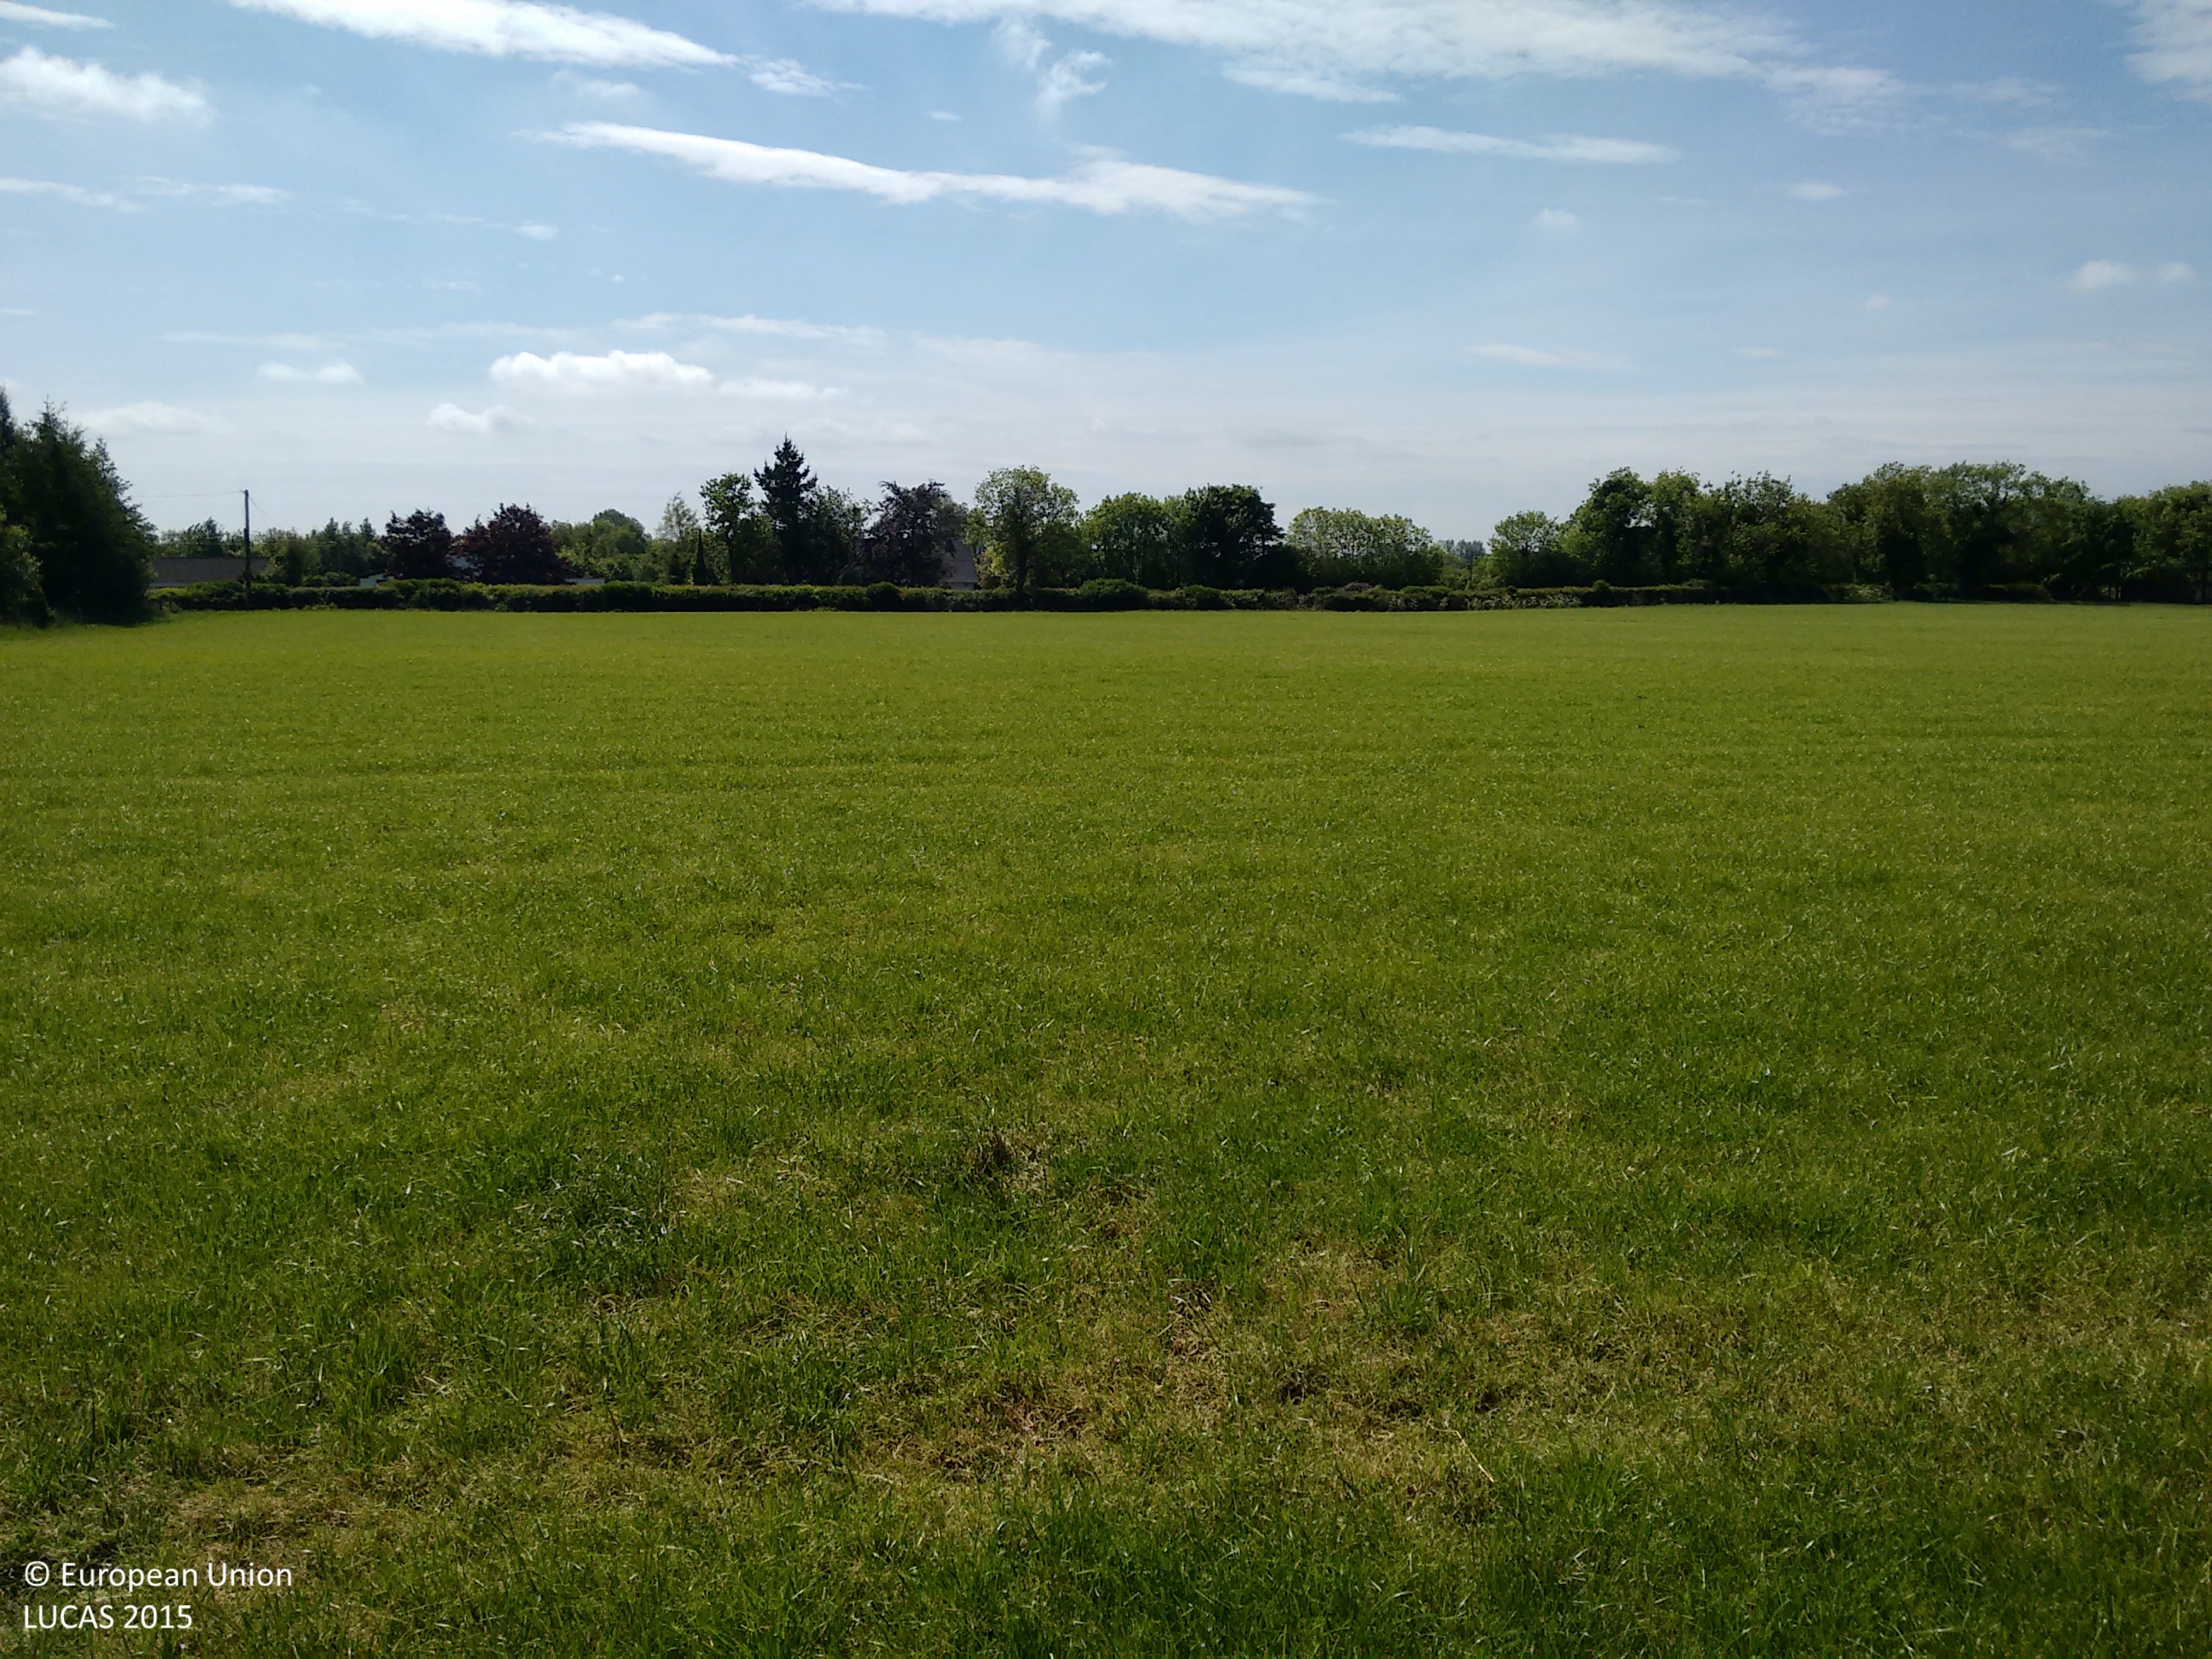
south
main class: Grassland
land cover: Grassland without tree/shrub cover
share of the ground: > 75 %
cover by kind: herbaceous plants 90 %, unconsolidated bare surface 10 %
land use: Agriculture (excluding fallow land and kitchen gardens)
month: June
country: IE
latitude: 53.5932
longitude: -6.5510
